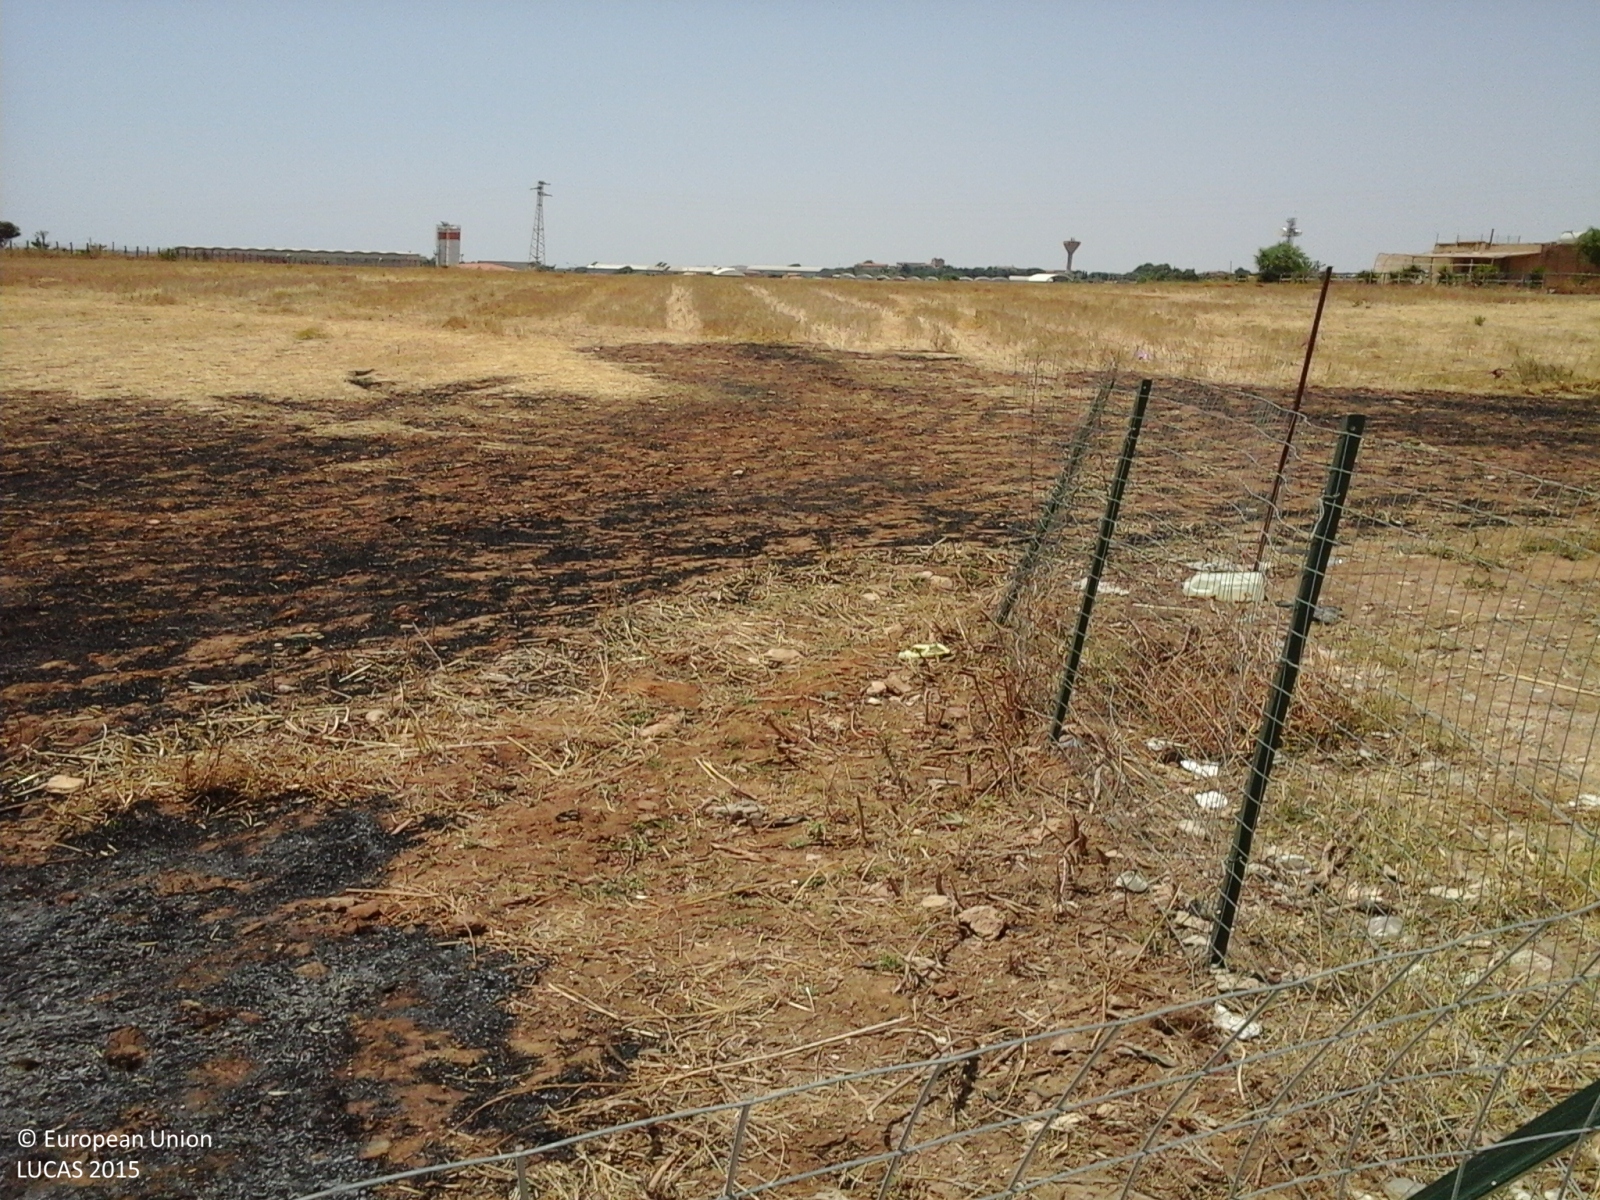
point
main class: Cropland
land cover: Durum wheat
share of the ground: > 75 %
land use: Agriculture (excluding fallow land and kitchen gardens)
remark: Burnt area
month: July
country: IT
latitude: 37.1541
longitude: 14.4133
